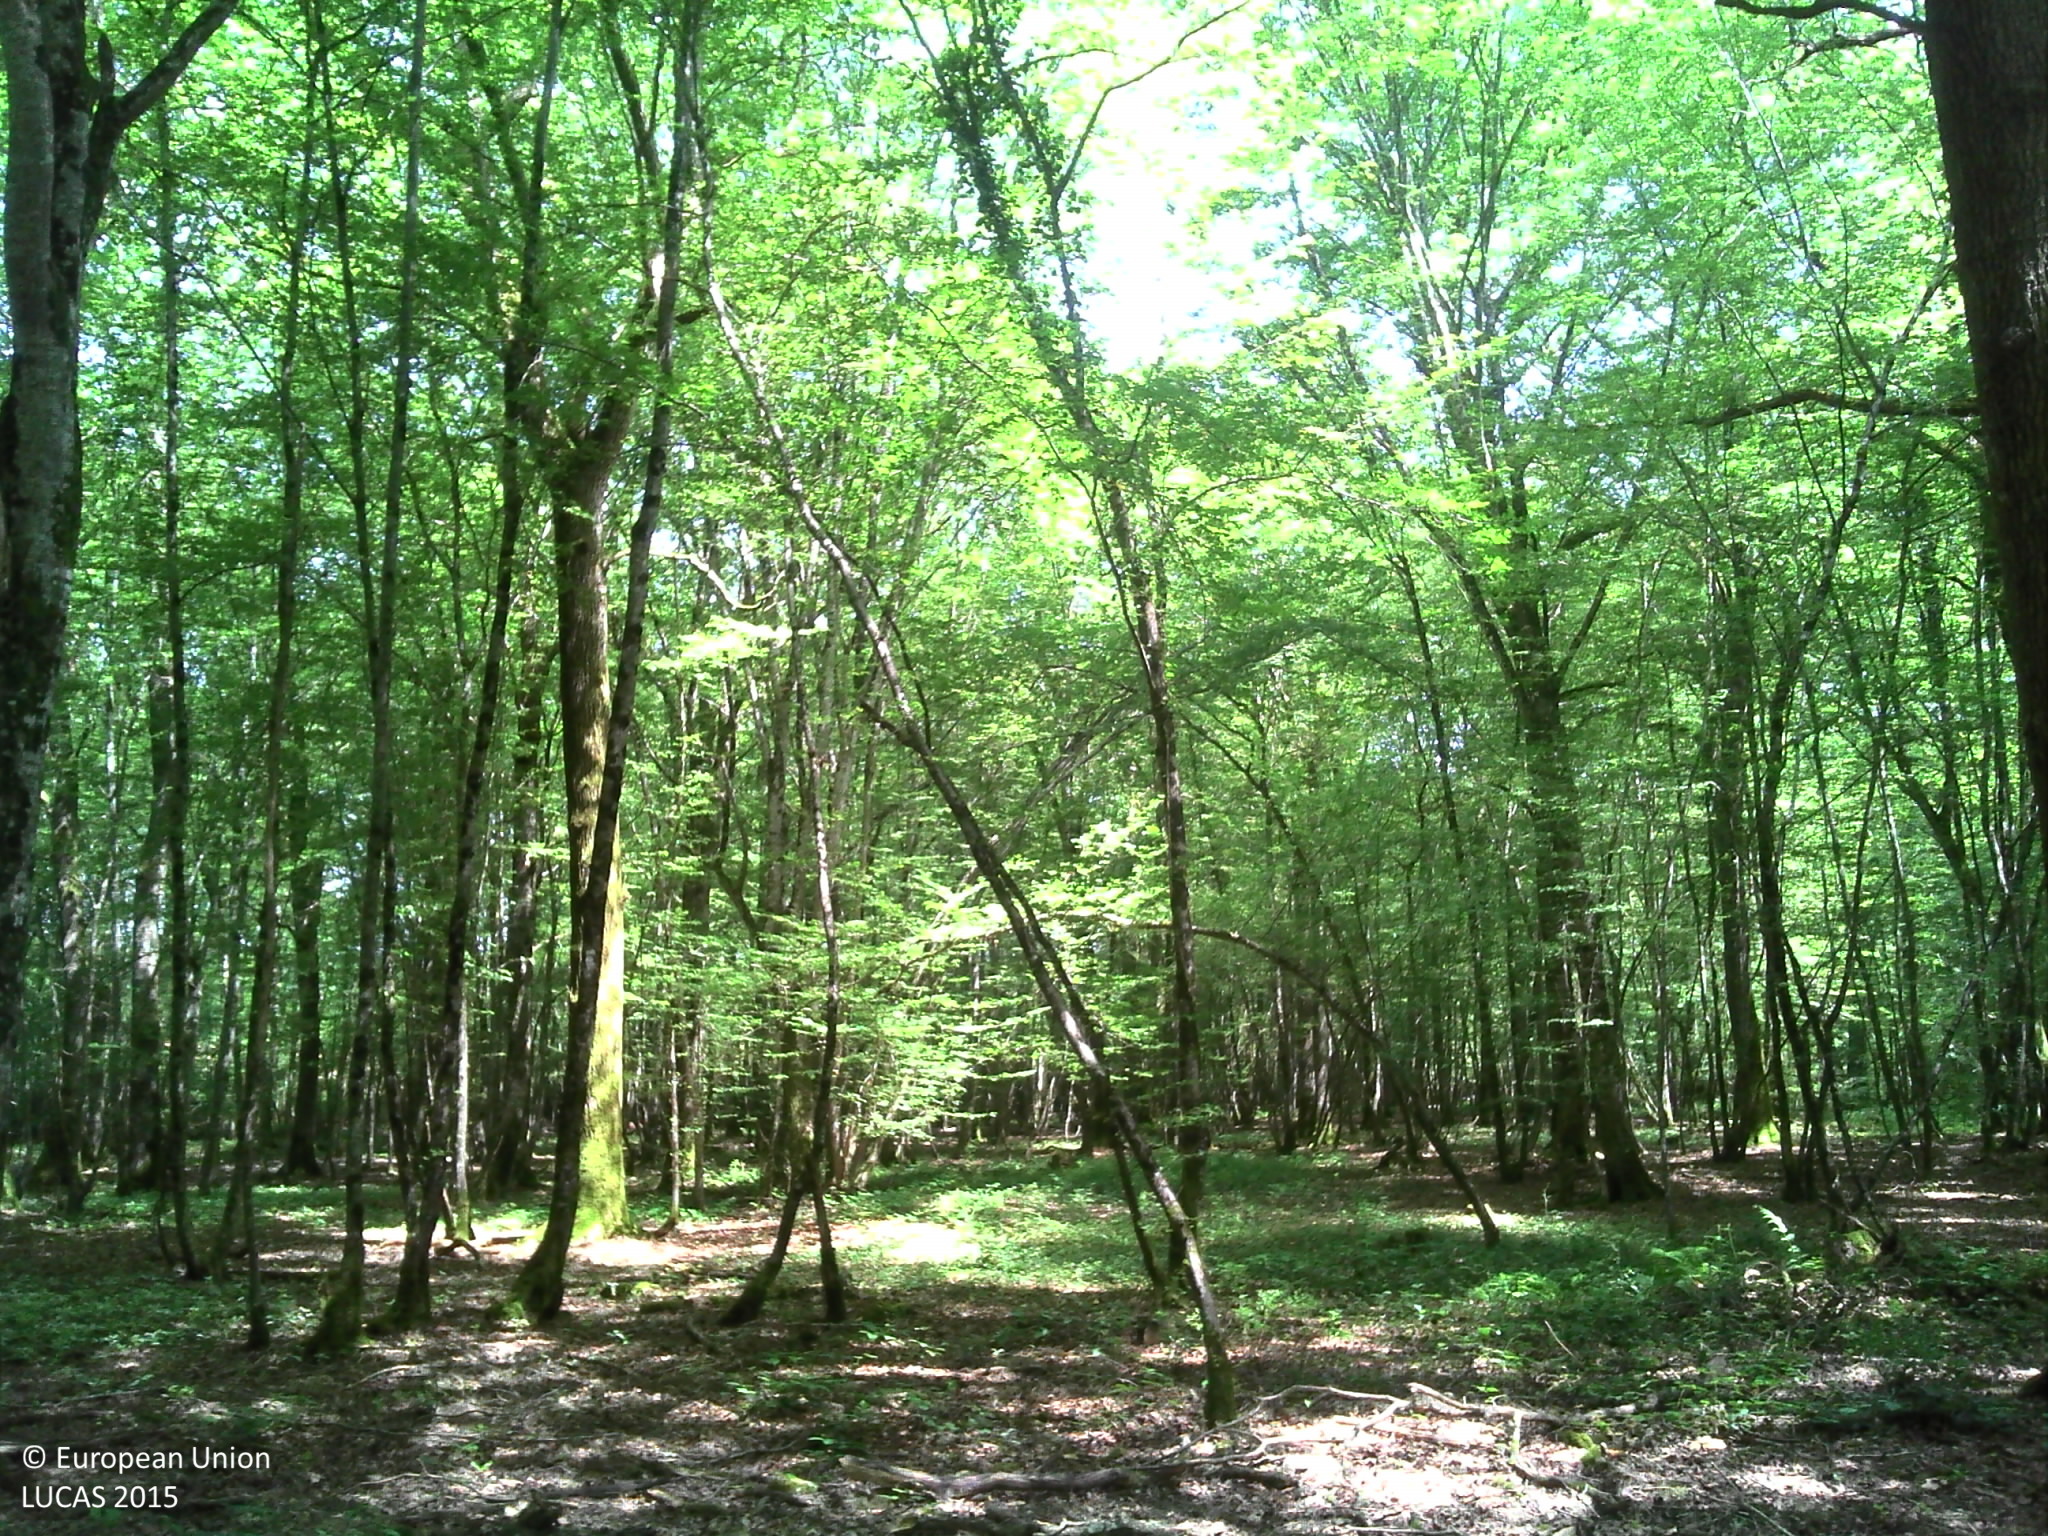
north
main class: Woodland
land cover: Broadleaved woodland
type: acidophilous oak and oak-birch forest
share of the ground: > 75 %
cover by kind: broadleaved forest trees 100 %
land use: Forestry
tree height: > 5 m
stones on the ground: < 10 %
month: June
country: FR
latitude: 47.0047
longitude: 2.9590
